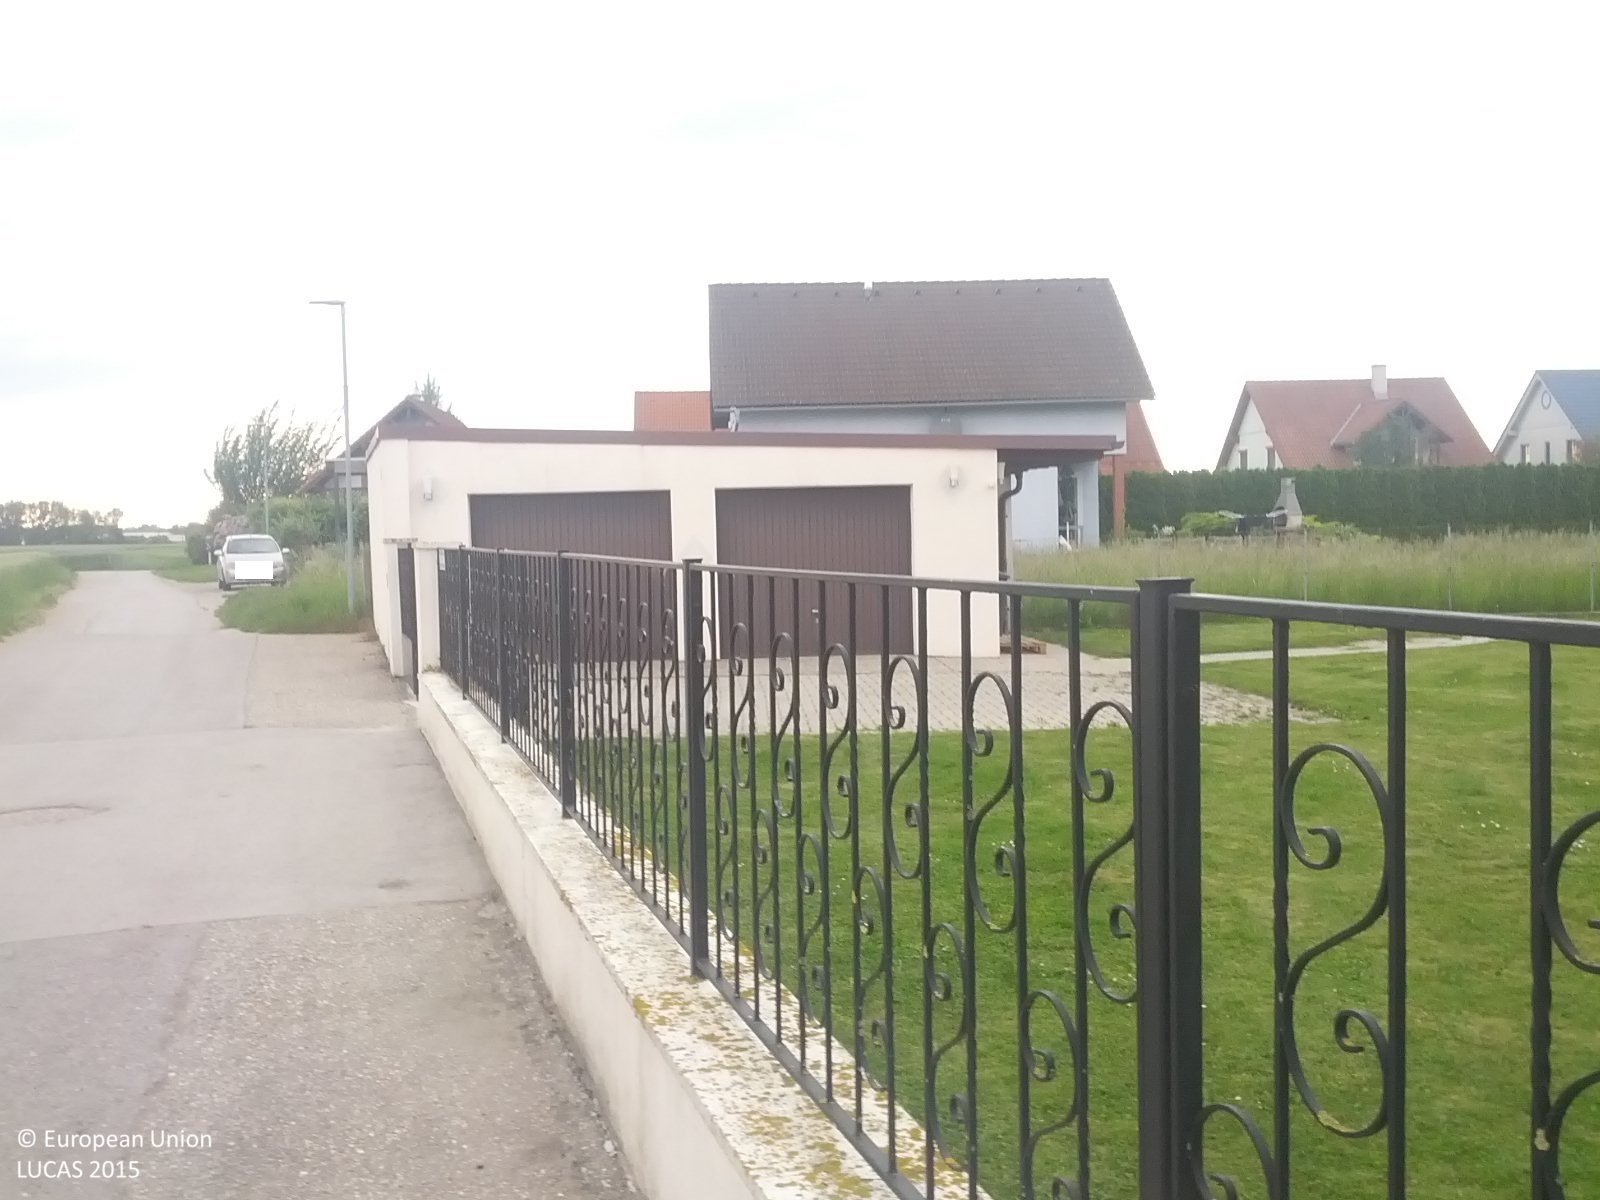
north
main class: Grassland
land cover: Grassland with sparse tree/shrub cover
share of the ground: > 75 %
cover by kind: herbaceous plants 90 %, coniferous forest trees 5 %, shrubs 5 %
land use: Residential
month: May
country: AT
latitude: 48.3230
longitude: 16.1409
